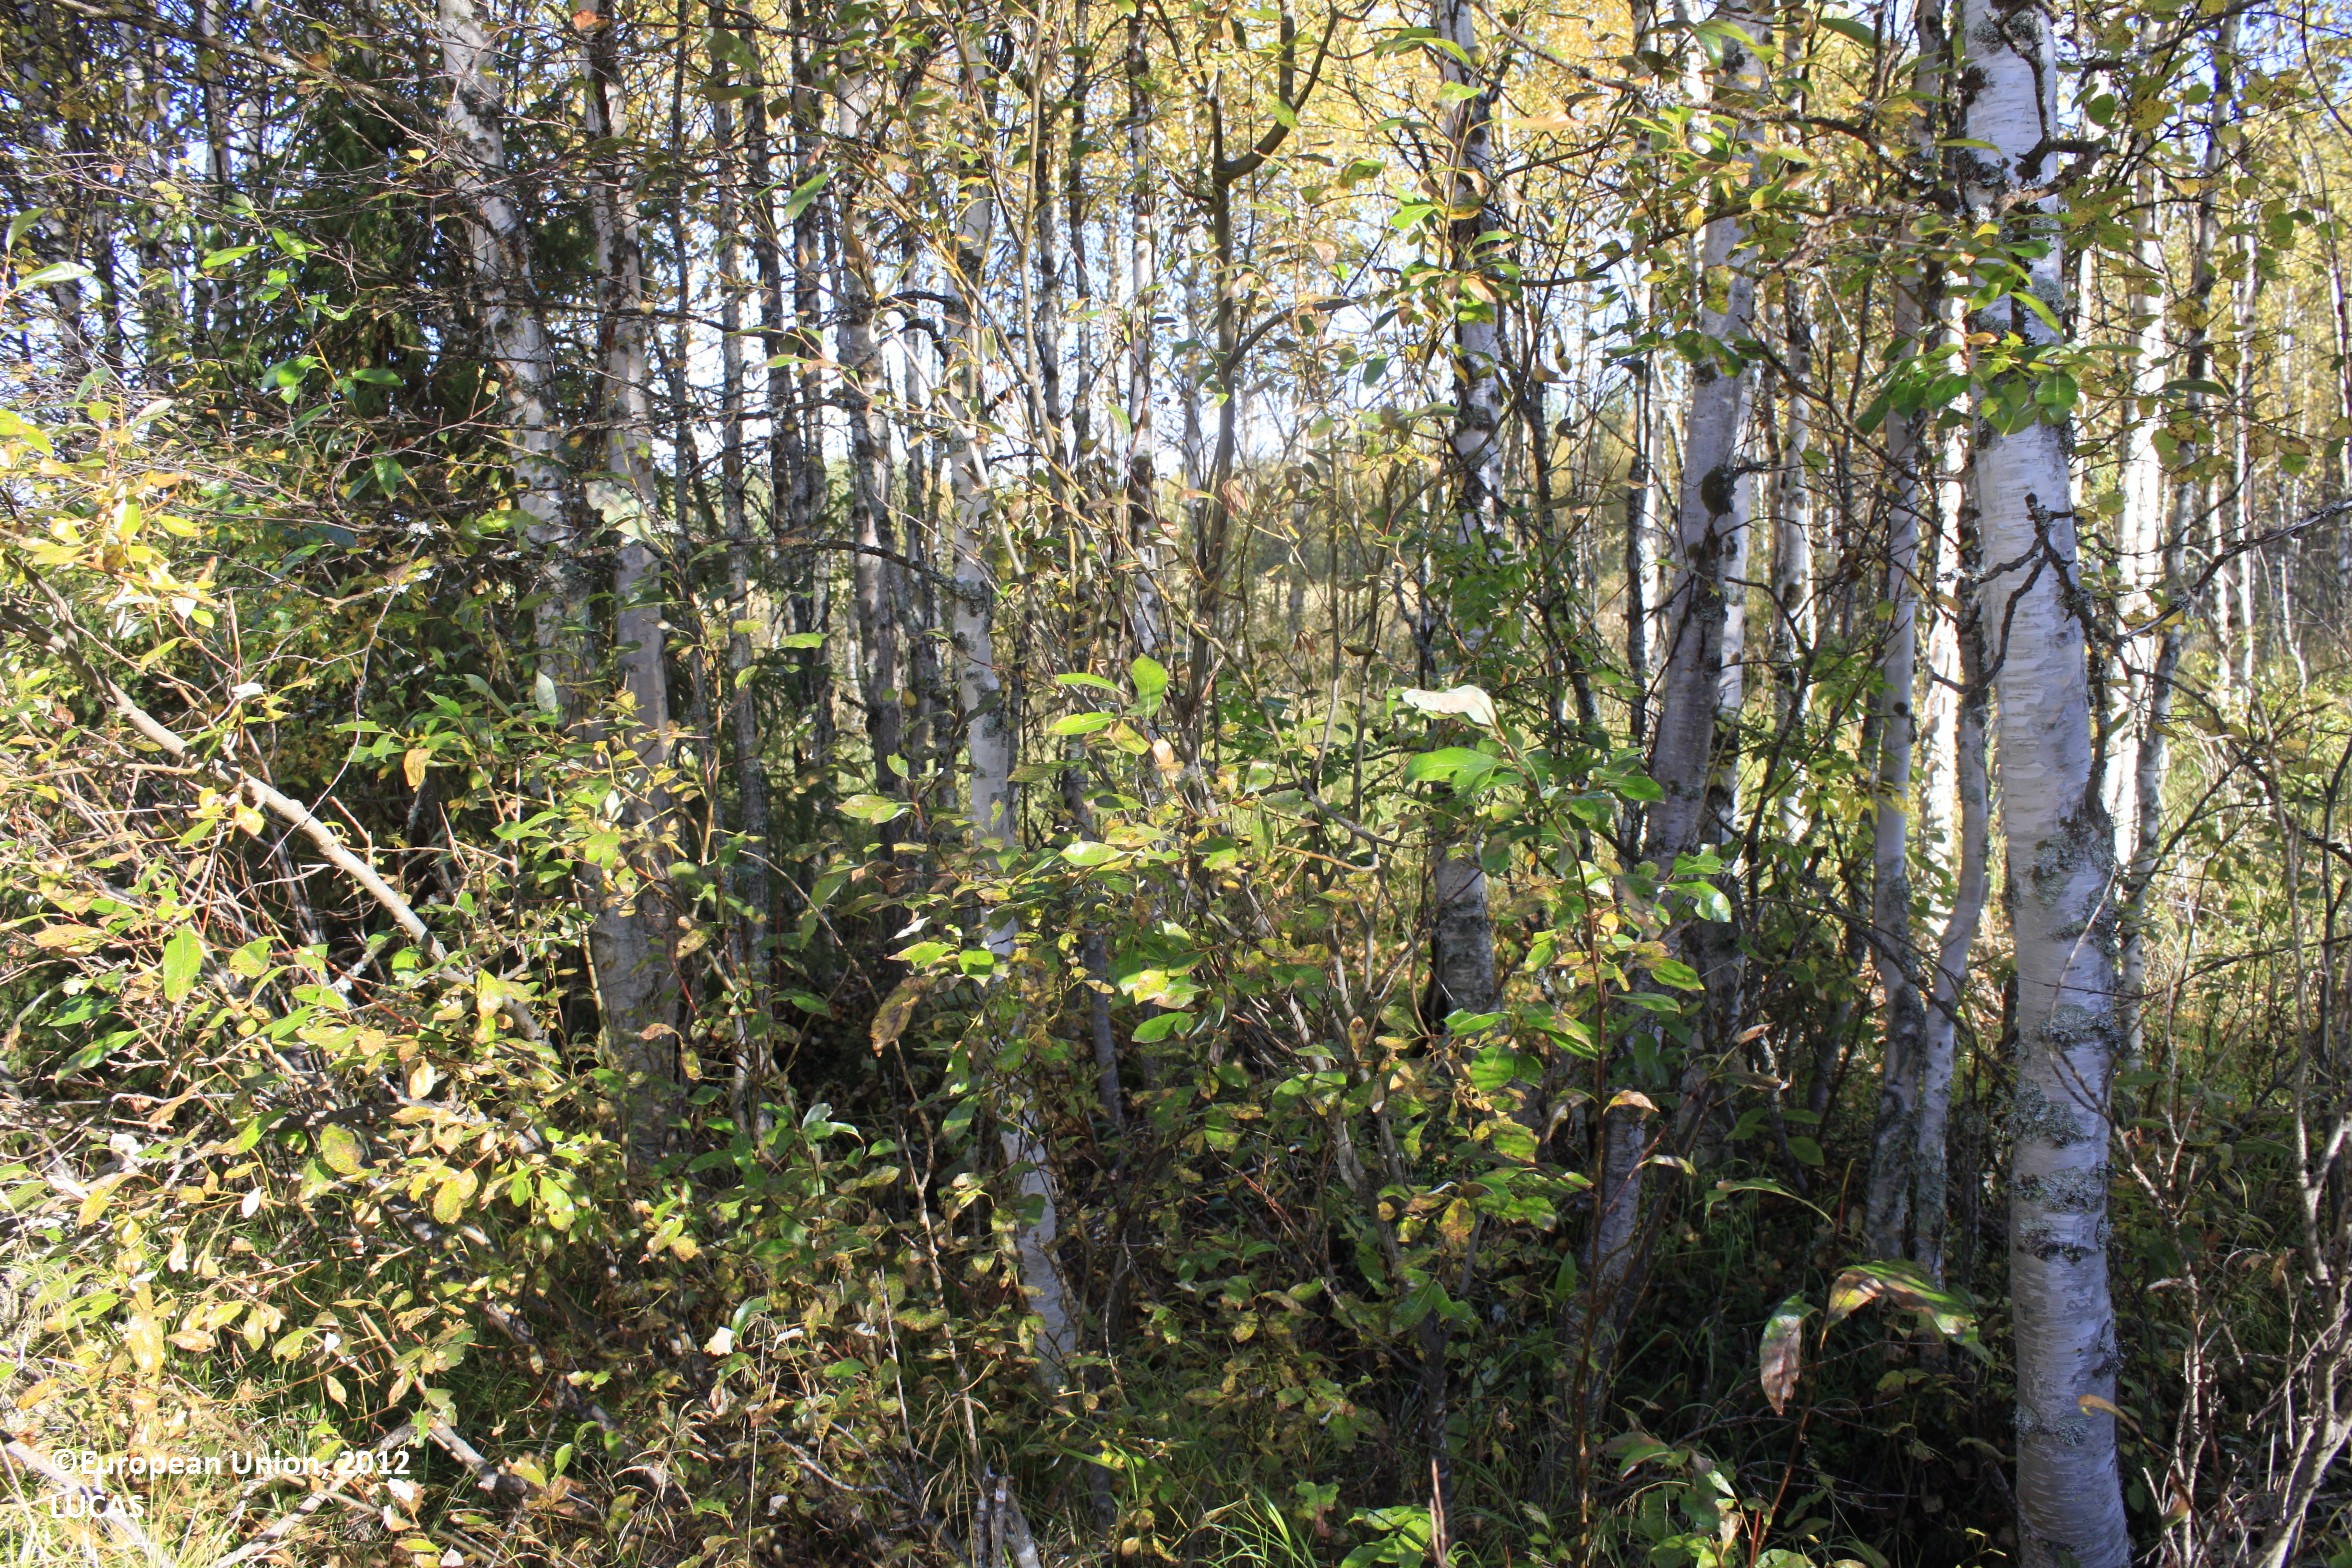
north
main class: Woodland
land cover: Broadleaved woodland
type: boreal forest
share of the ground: 50 - 75 %
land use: Forestry
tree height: > 5 m
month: September
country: FI
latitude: 65.6147
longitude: 26.5770
